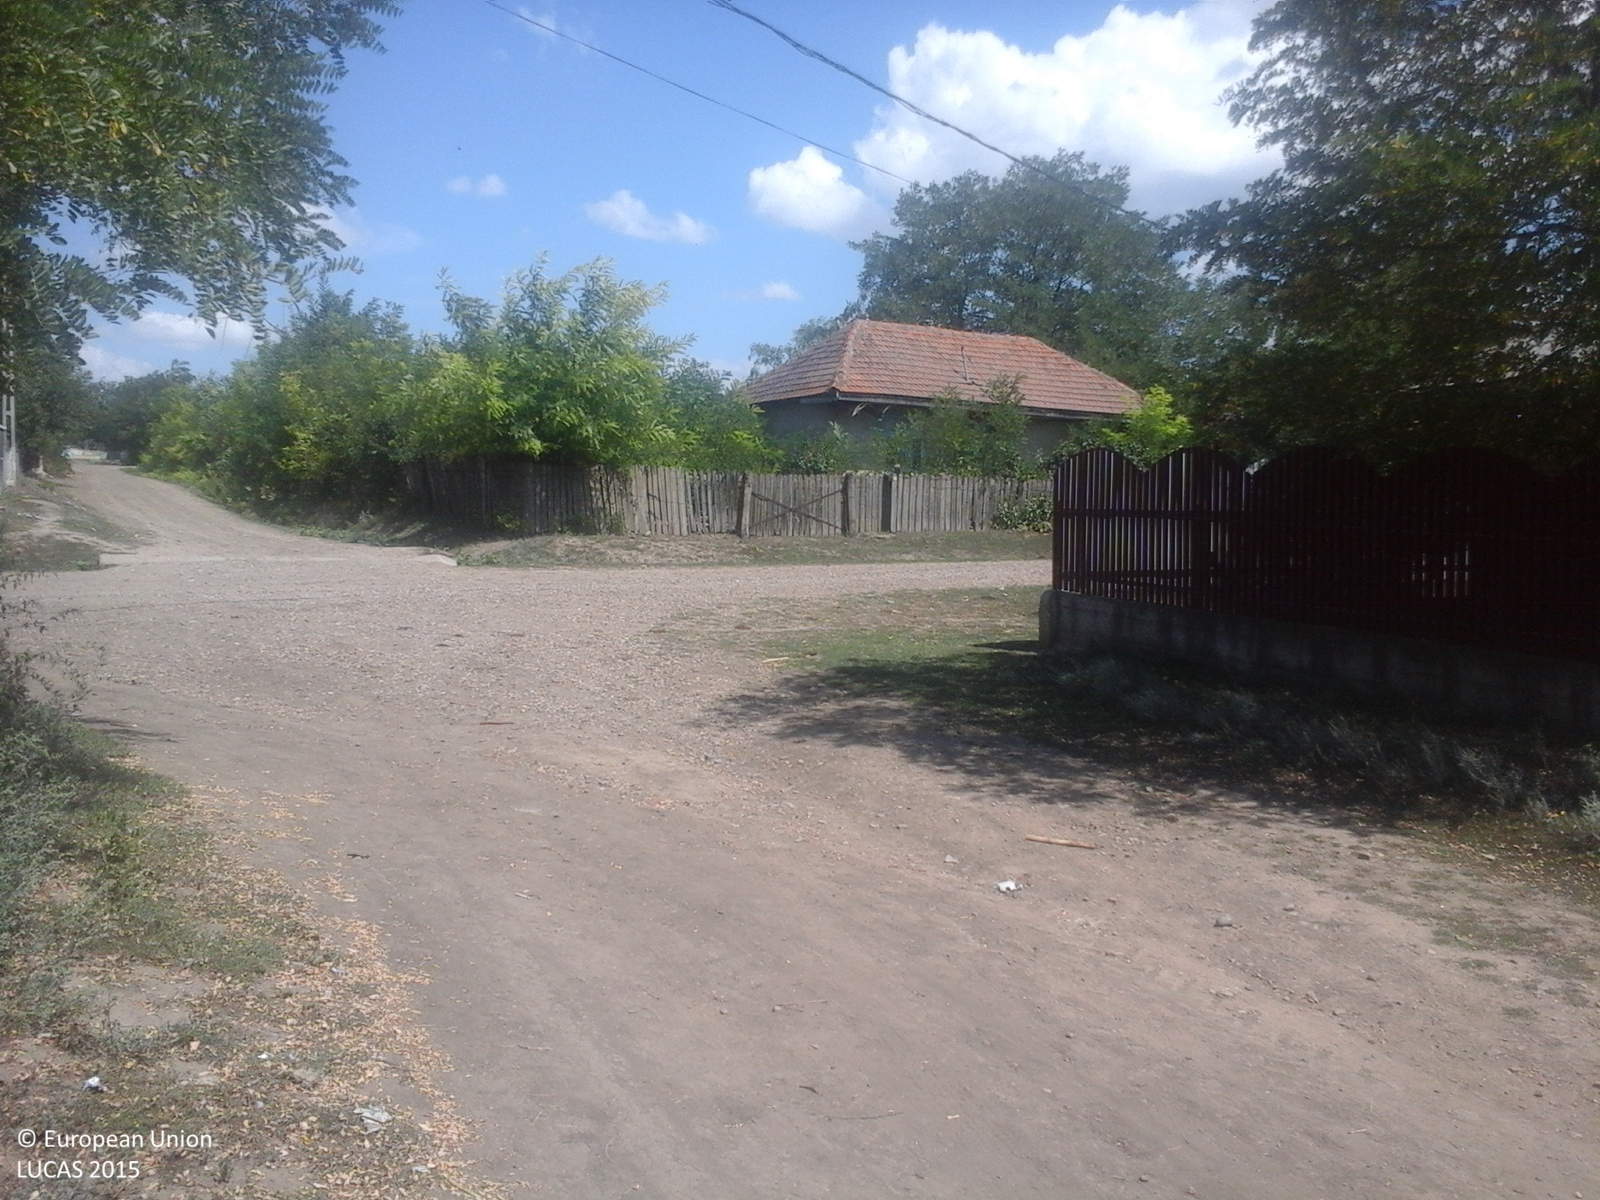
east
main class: Grassland
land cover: Spontaneously vegetated surfaces
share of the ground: > 75 %
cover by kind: herbaceous plants 100 %
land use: Fallow land
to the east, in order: Spontaneously vegetated surfaces; Artificial constructions in urban areas; Other fruit trees and berries; Fences; Spontaneously vegetated surfaces; Fences; Lucerne; Artificial constructions in urban areas
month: July
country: RO
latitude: 46.4313
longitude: 28.1013
